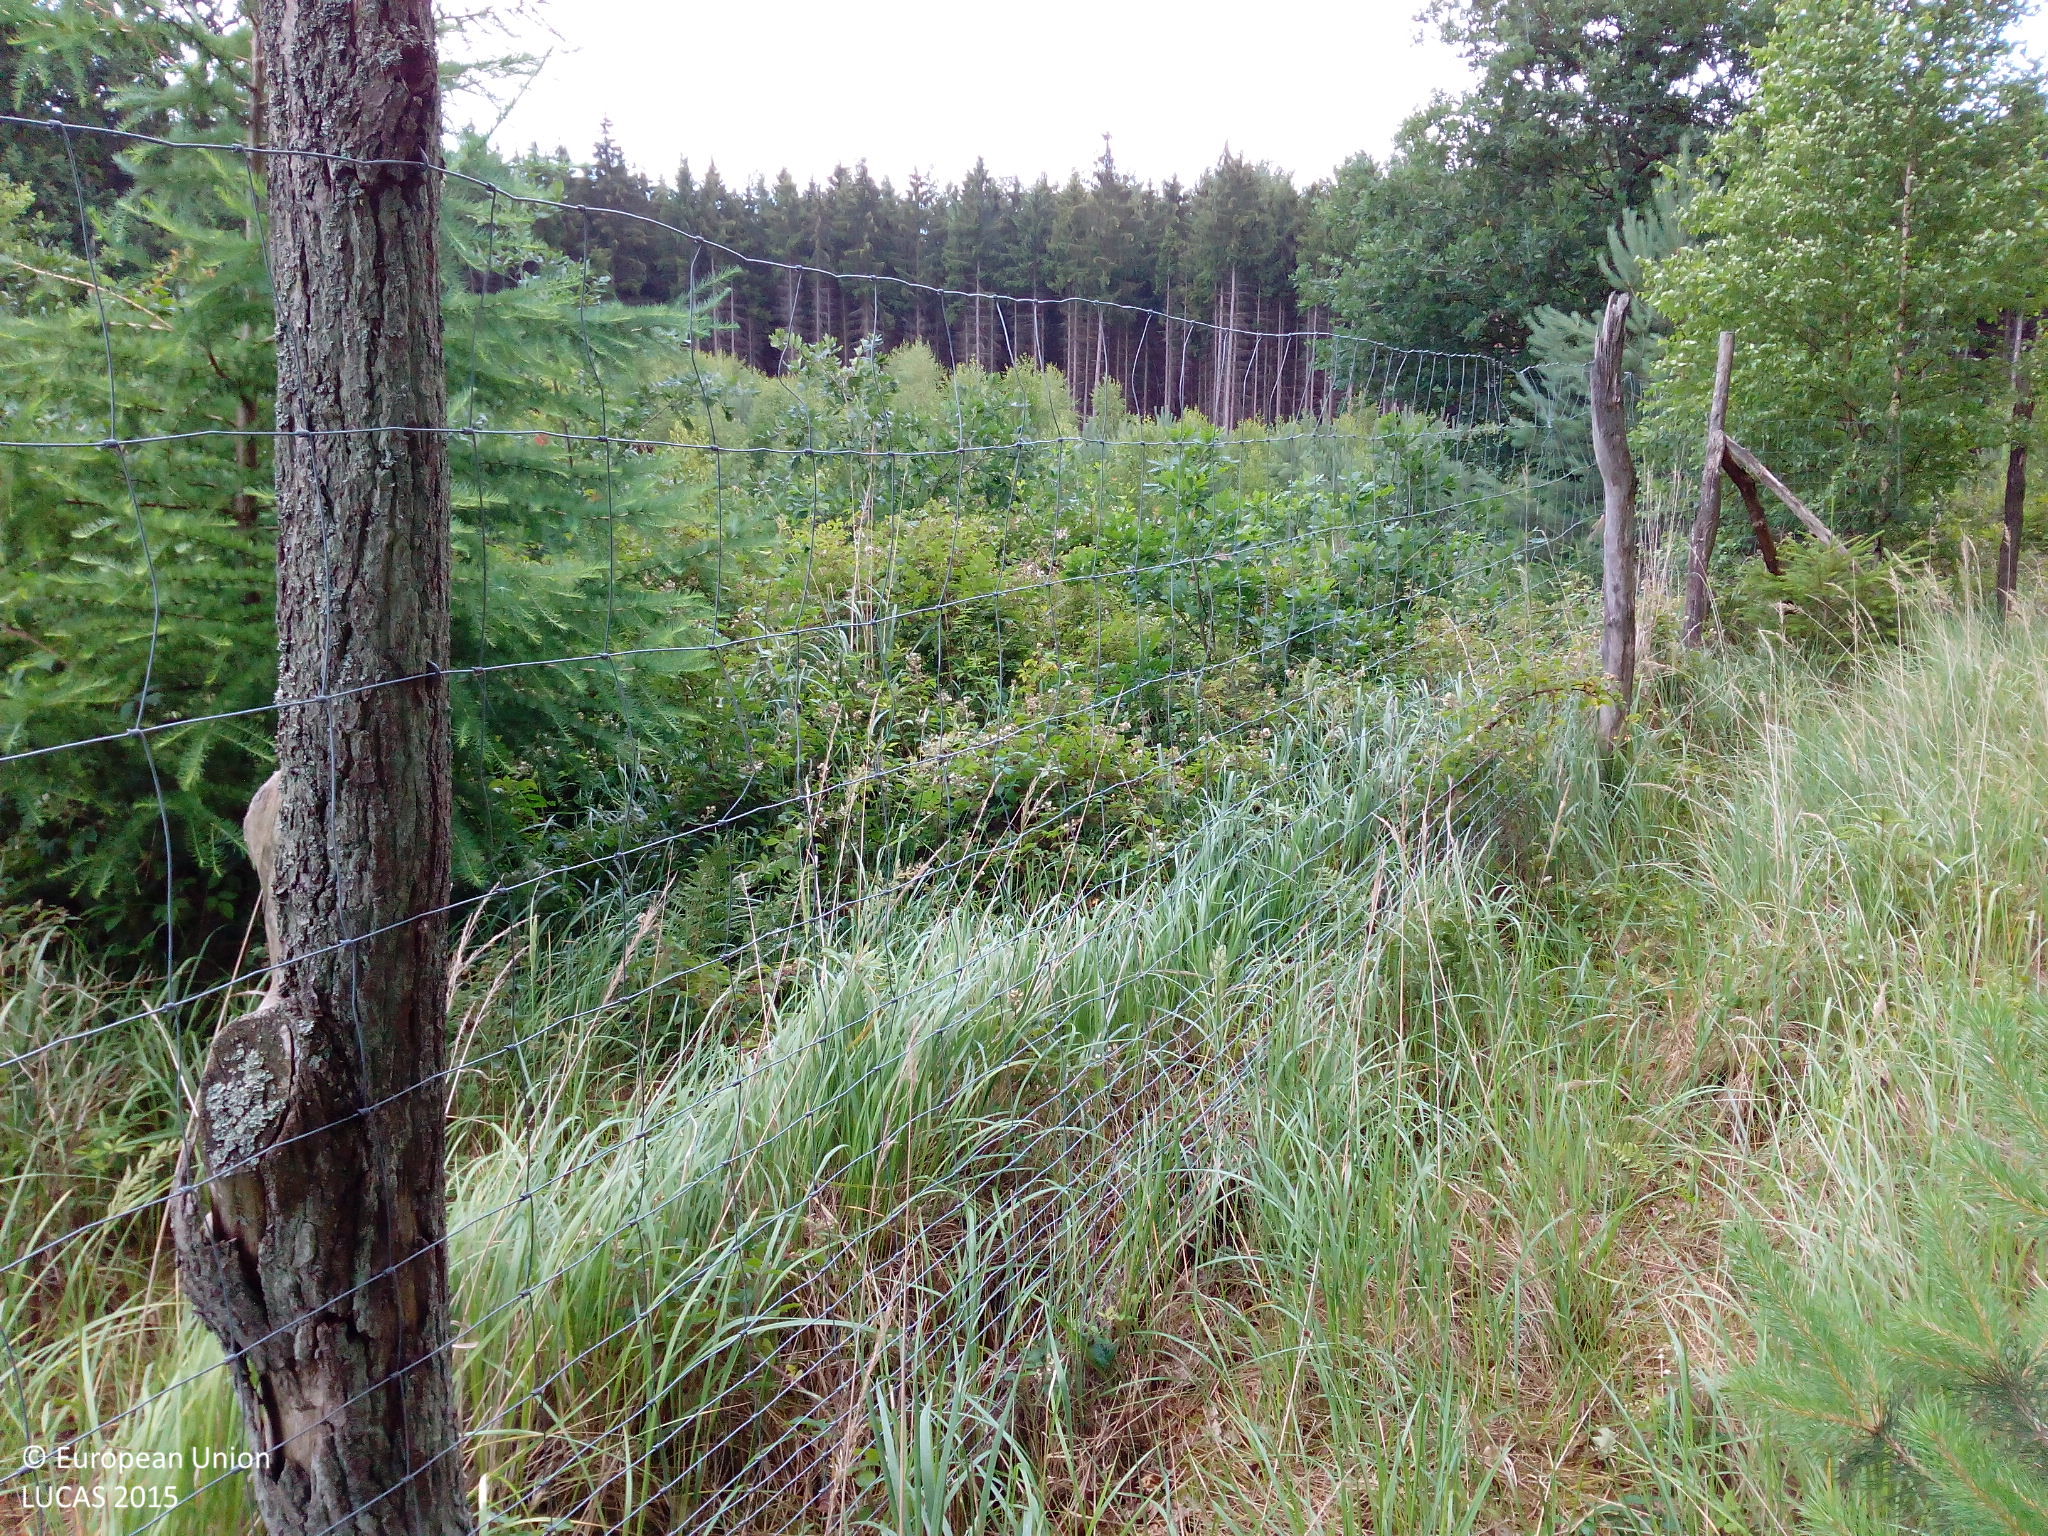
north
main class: Woodland
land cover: Broadleaved woodland
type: mesophytic deciduous forest
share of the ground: 50 - 75 %
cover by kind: broadleaved forest trees 50 %, shrubs 25 %, herbaceous plants 20 %, coniferous forest trees 5 %
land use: Forestry
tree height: < 5 m
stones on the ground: < 10 %
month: July
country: DE
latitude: 52.8804
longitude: 13.6110
